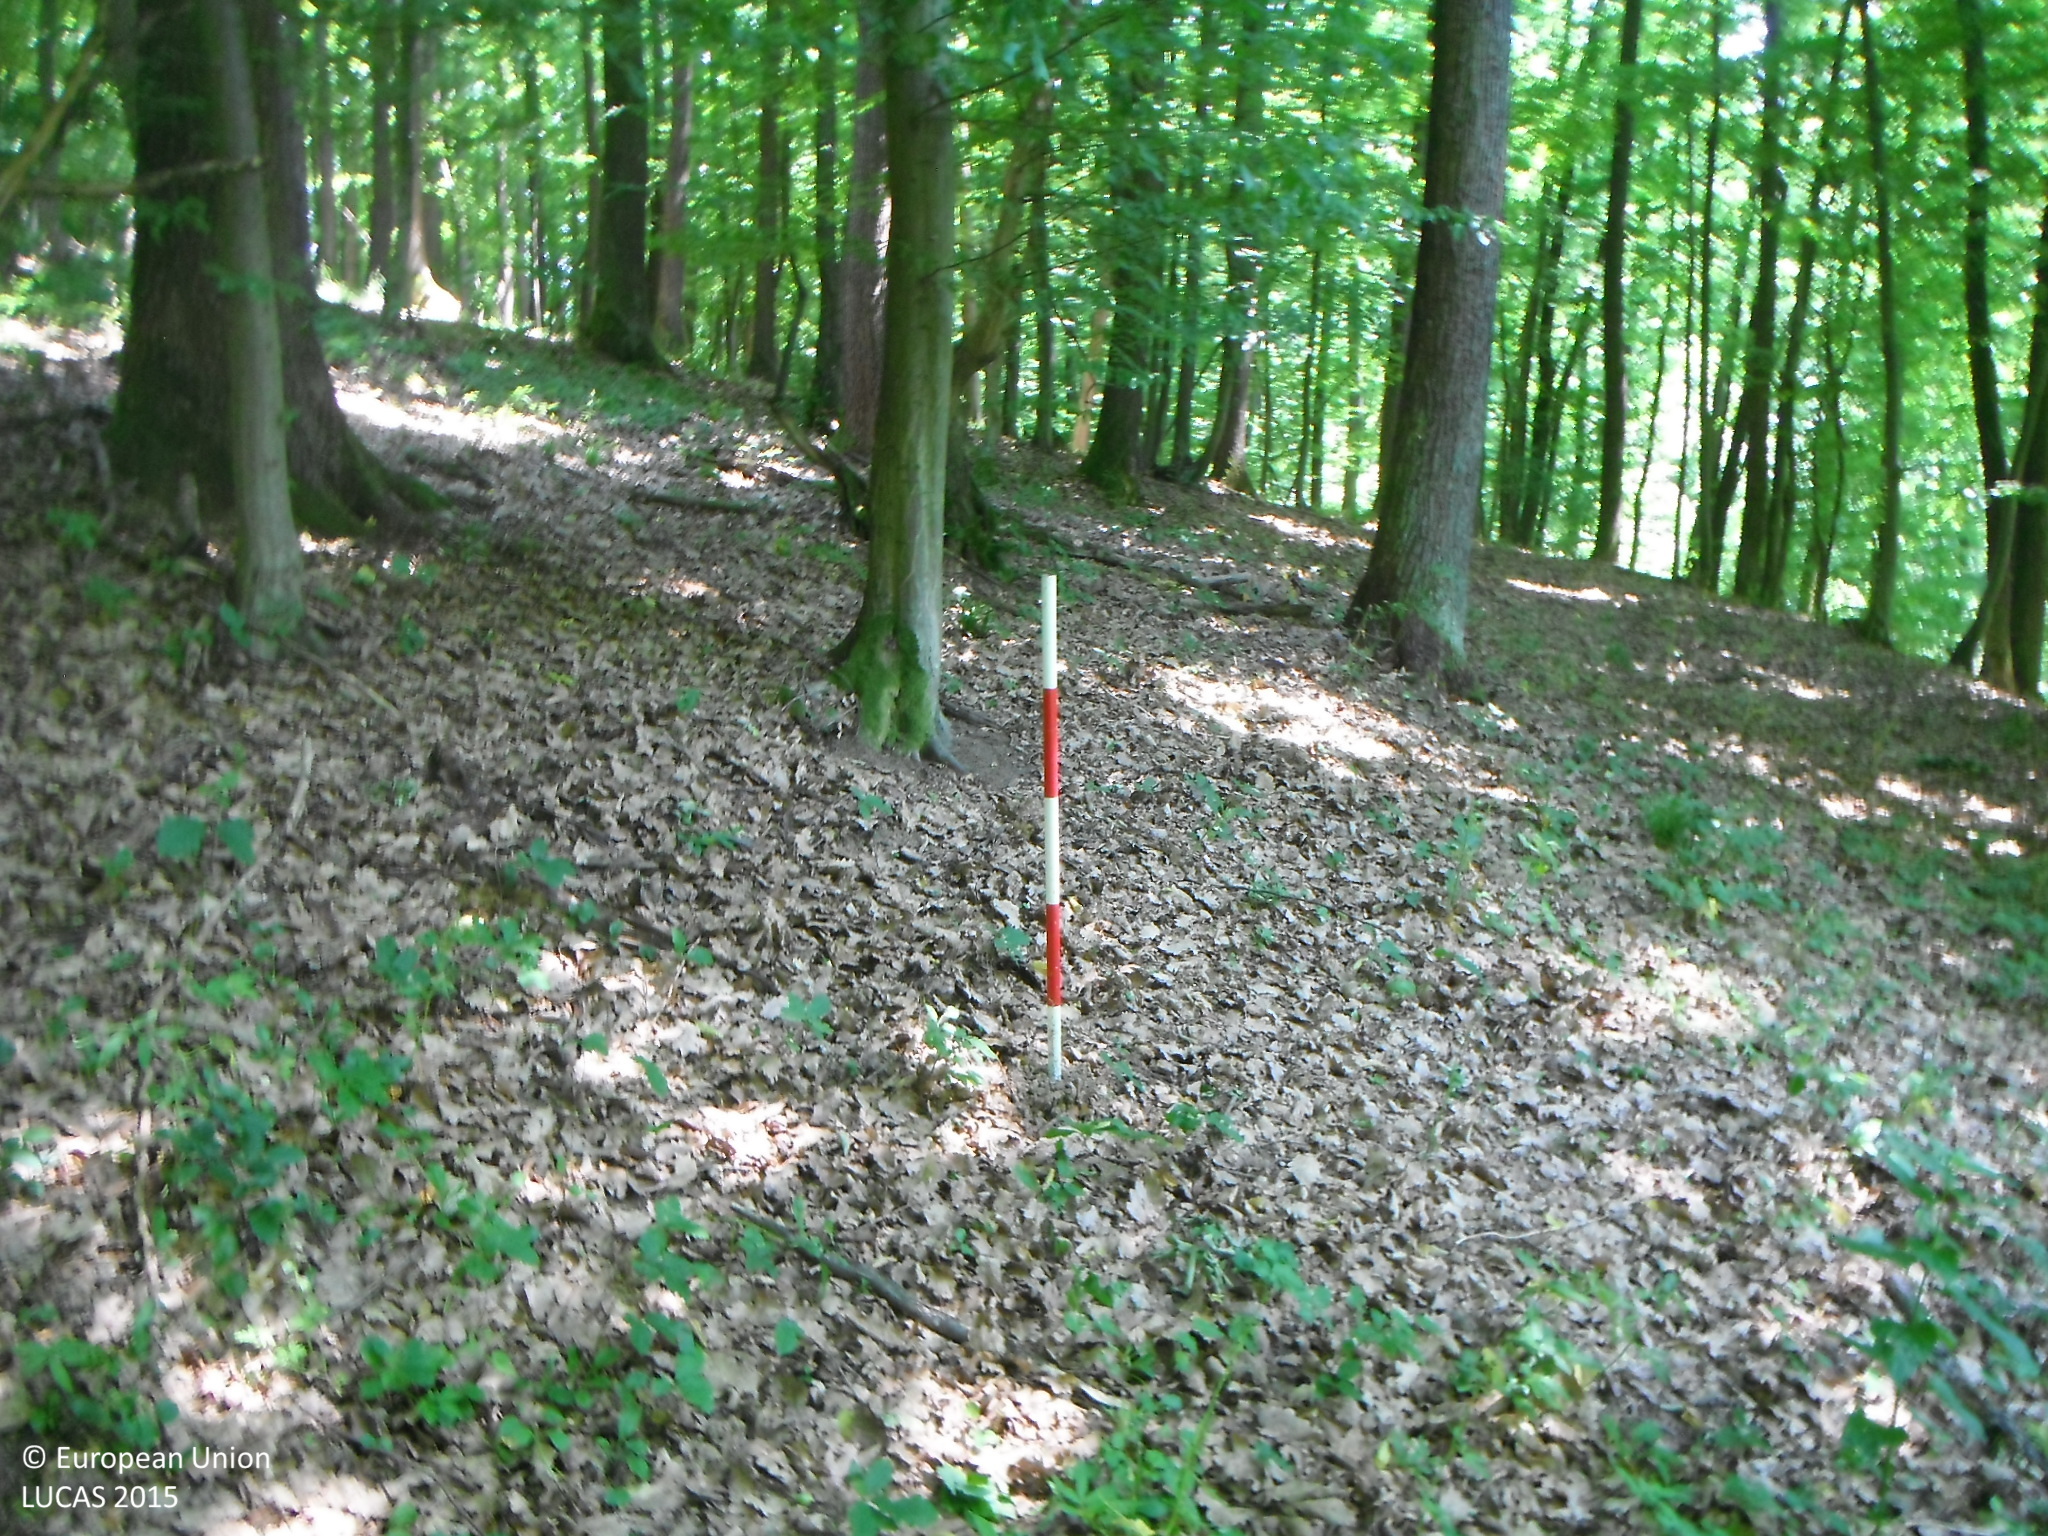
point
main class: Woodland
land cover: Broadleaved woodland
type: mesophytic deciduous forest
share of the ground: > 75 %
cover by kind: broadleaved forest trees 100 %
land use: Forestry
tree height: > 5 m
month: June
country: SK
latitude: 48.6720
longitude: 19.1889
